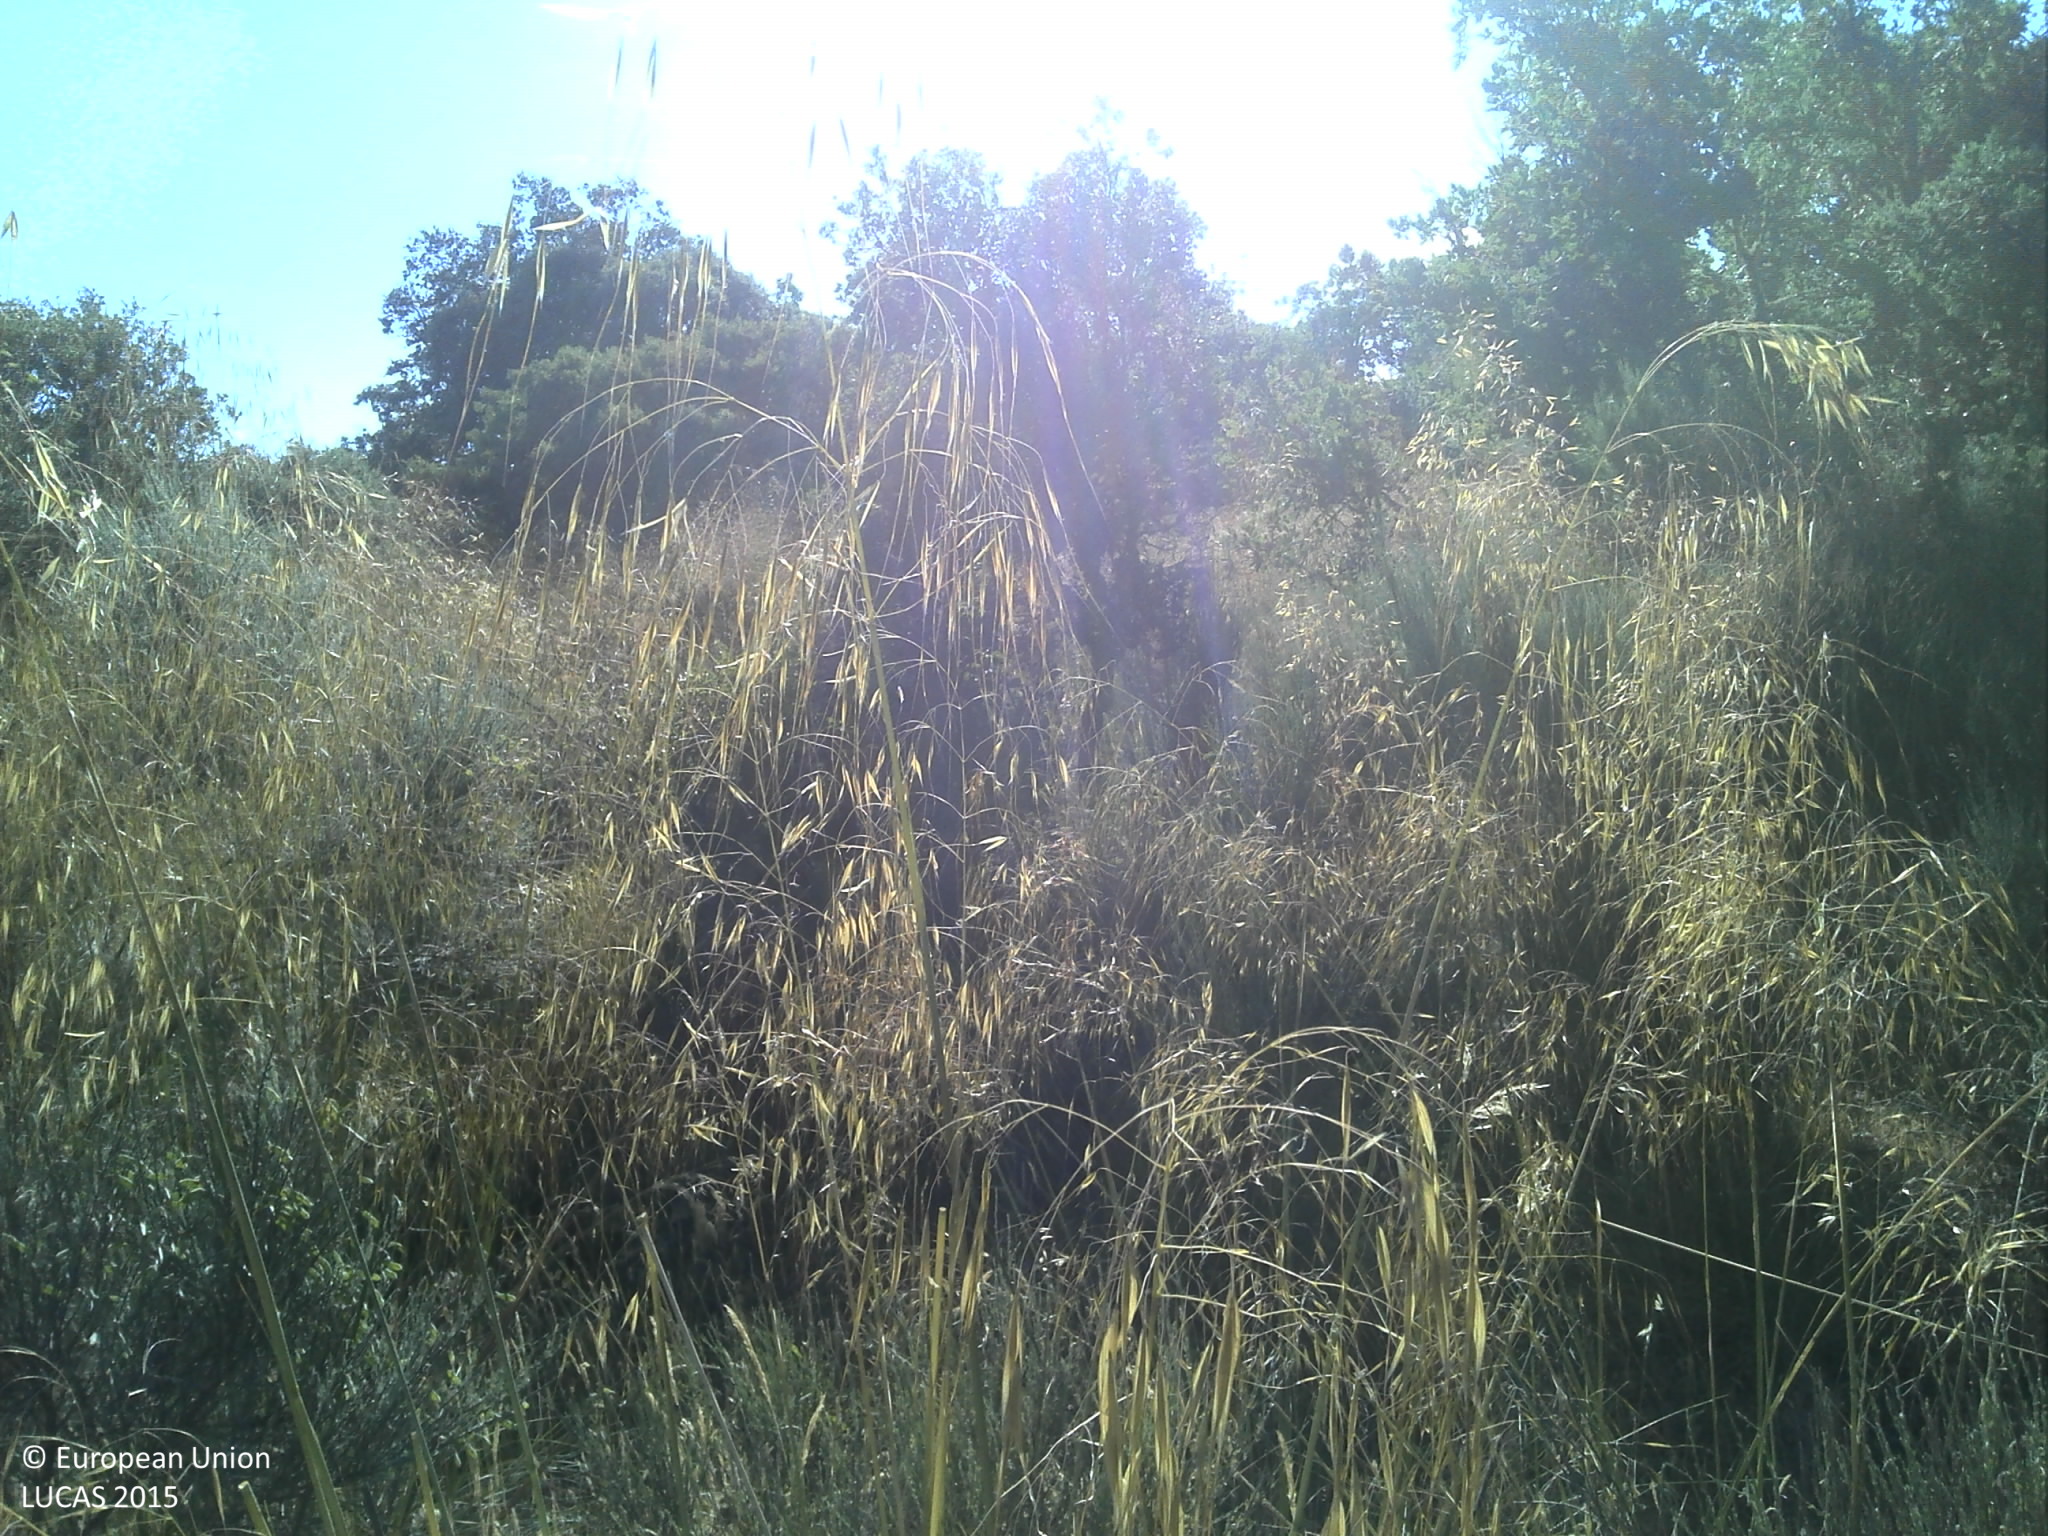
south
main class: Shrubland
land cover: Shrubland with sparse tree cover
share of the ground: 50 - 75 %
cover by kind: shrubs 65 %, herbaceous plants 15 %, unconsolidated bare surface 15 %, broadleaved forest trees 5 %
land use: Agriculture (excluding fallow land and kitchen gardens)
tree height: > 5 m
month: June
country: PT
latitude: 40.6661
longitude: -6.8115
